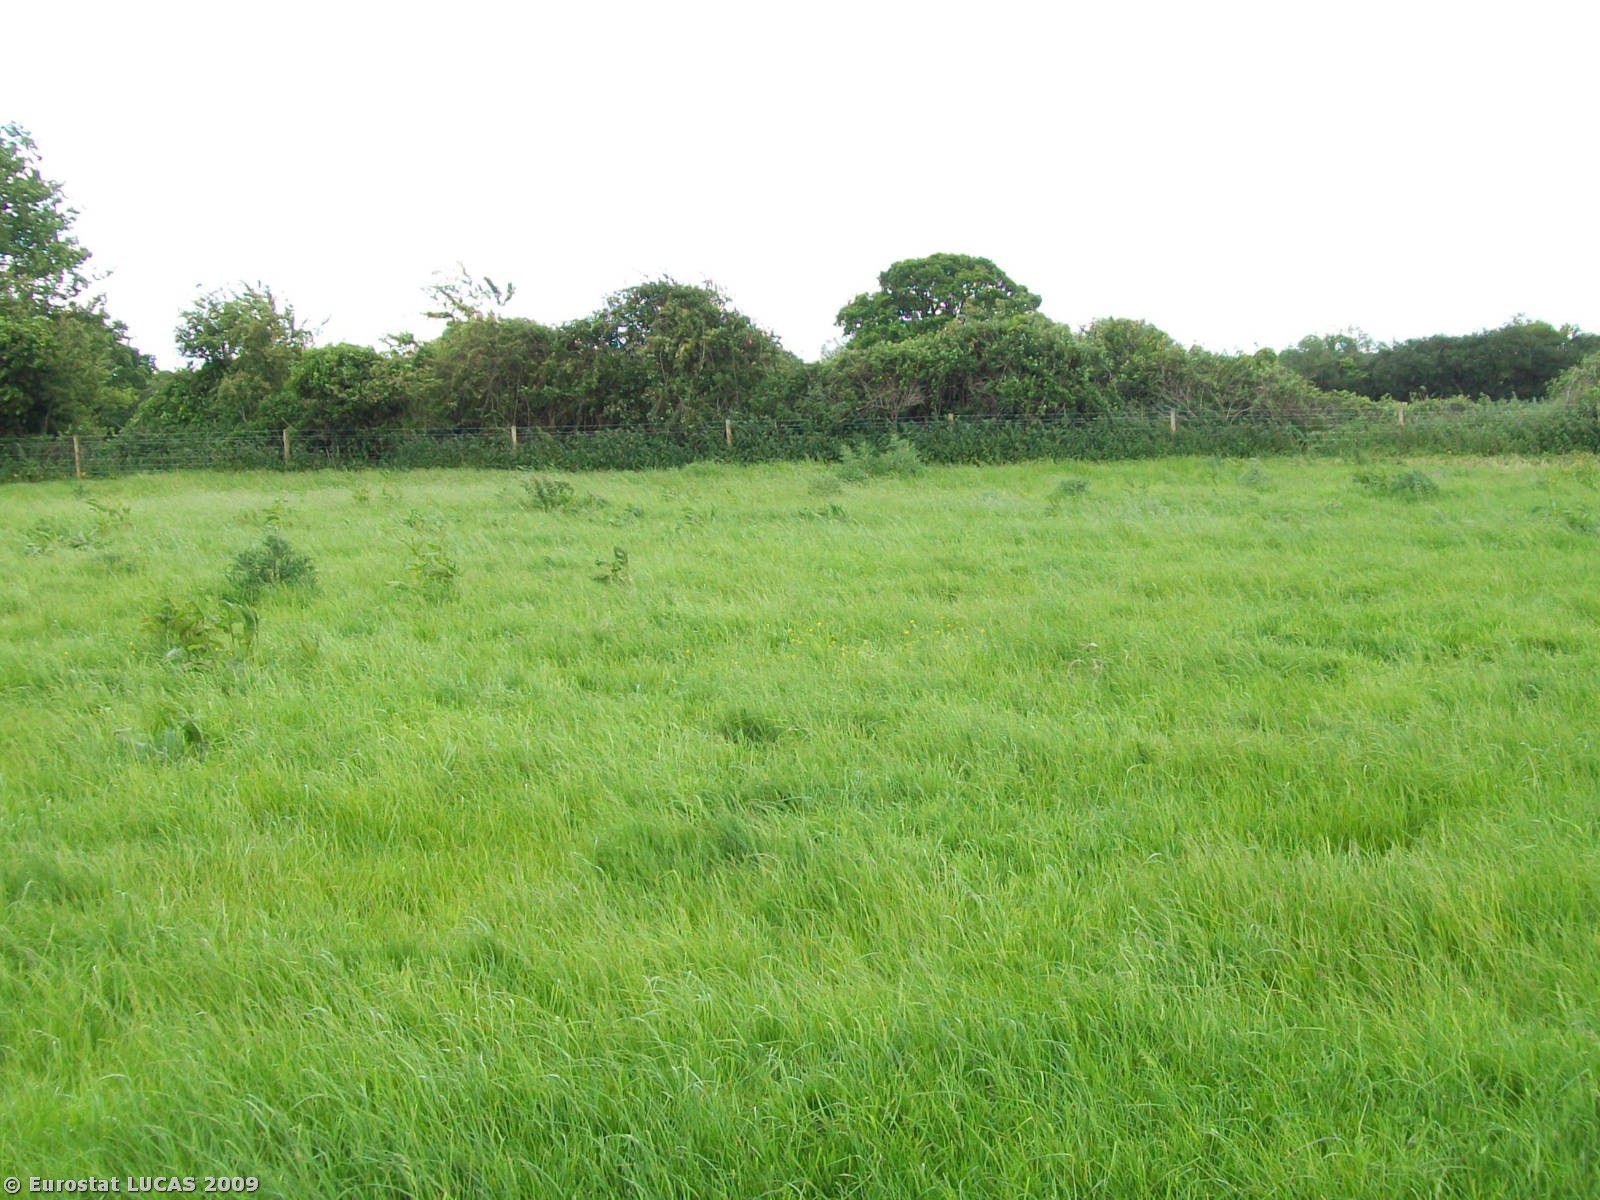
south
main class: Grassland
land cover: Grassland without tree/shrub cover
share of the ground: > 75 %
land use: Agriculture (excluding fallow land and kitchen gardens)
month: May
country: GB
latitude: 51.3488
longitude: -2.1648
